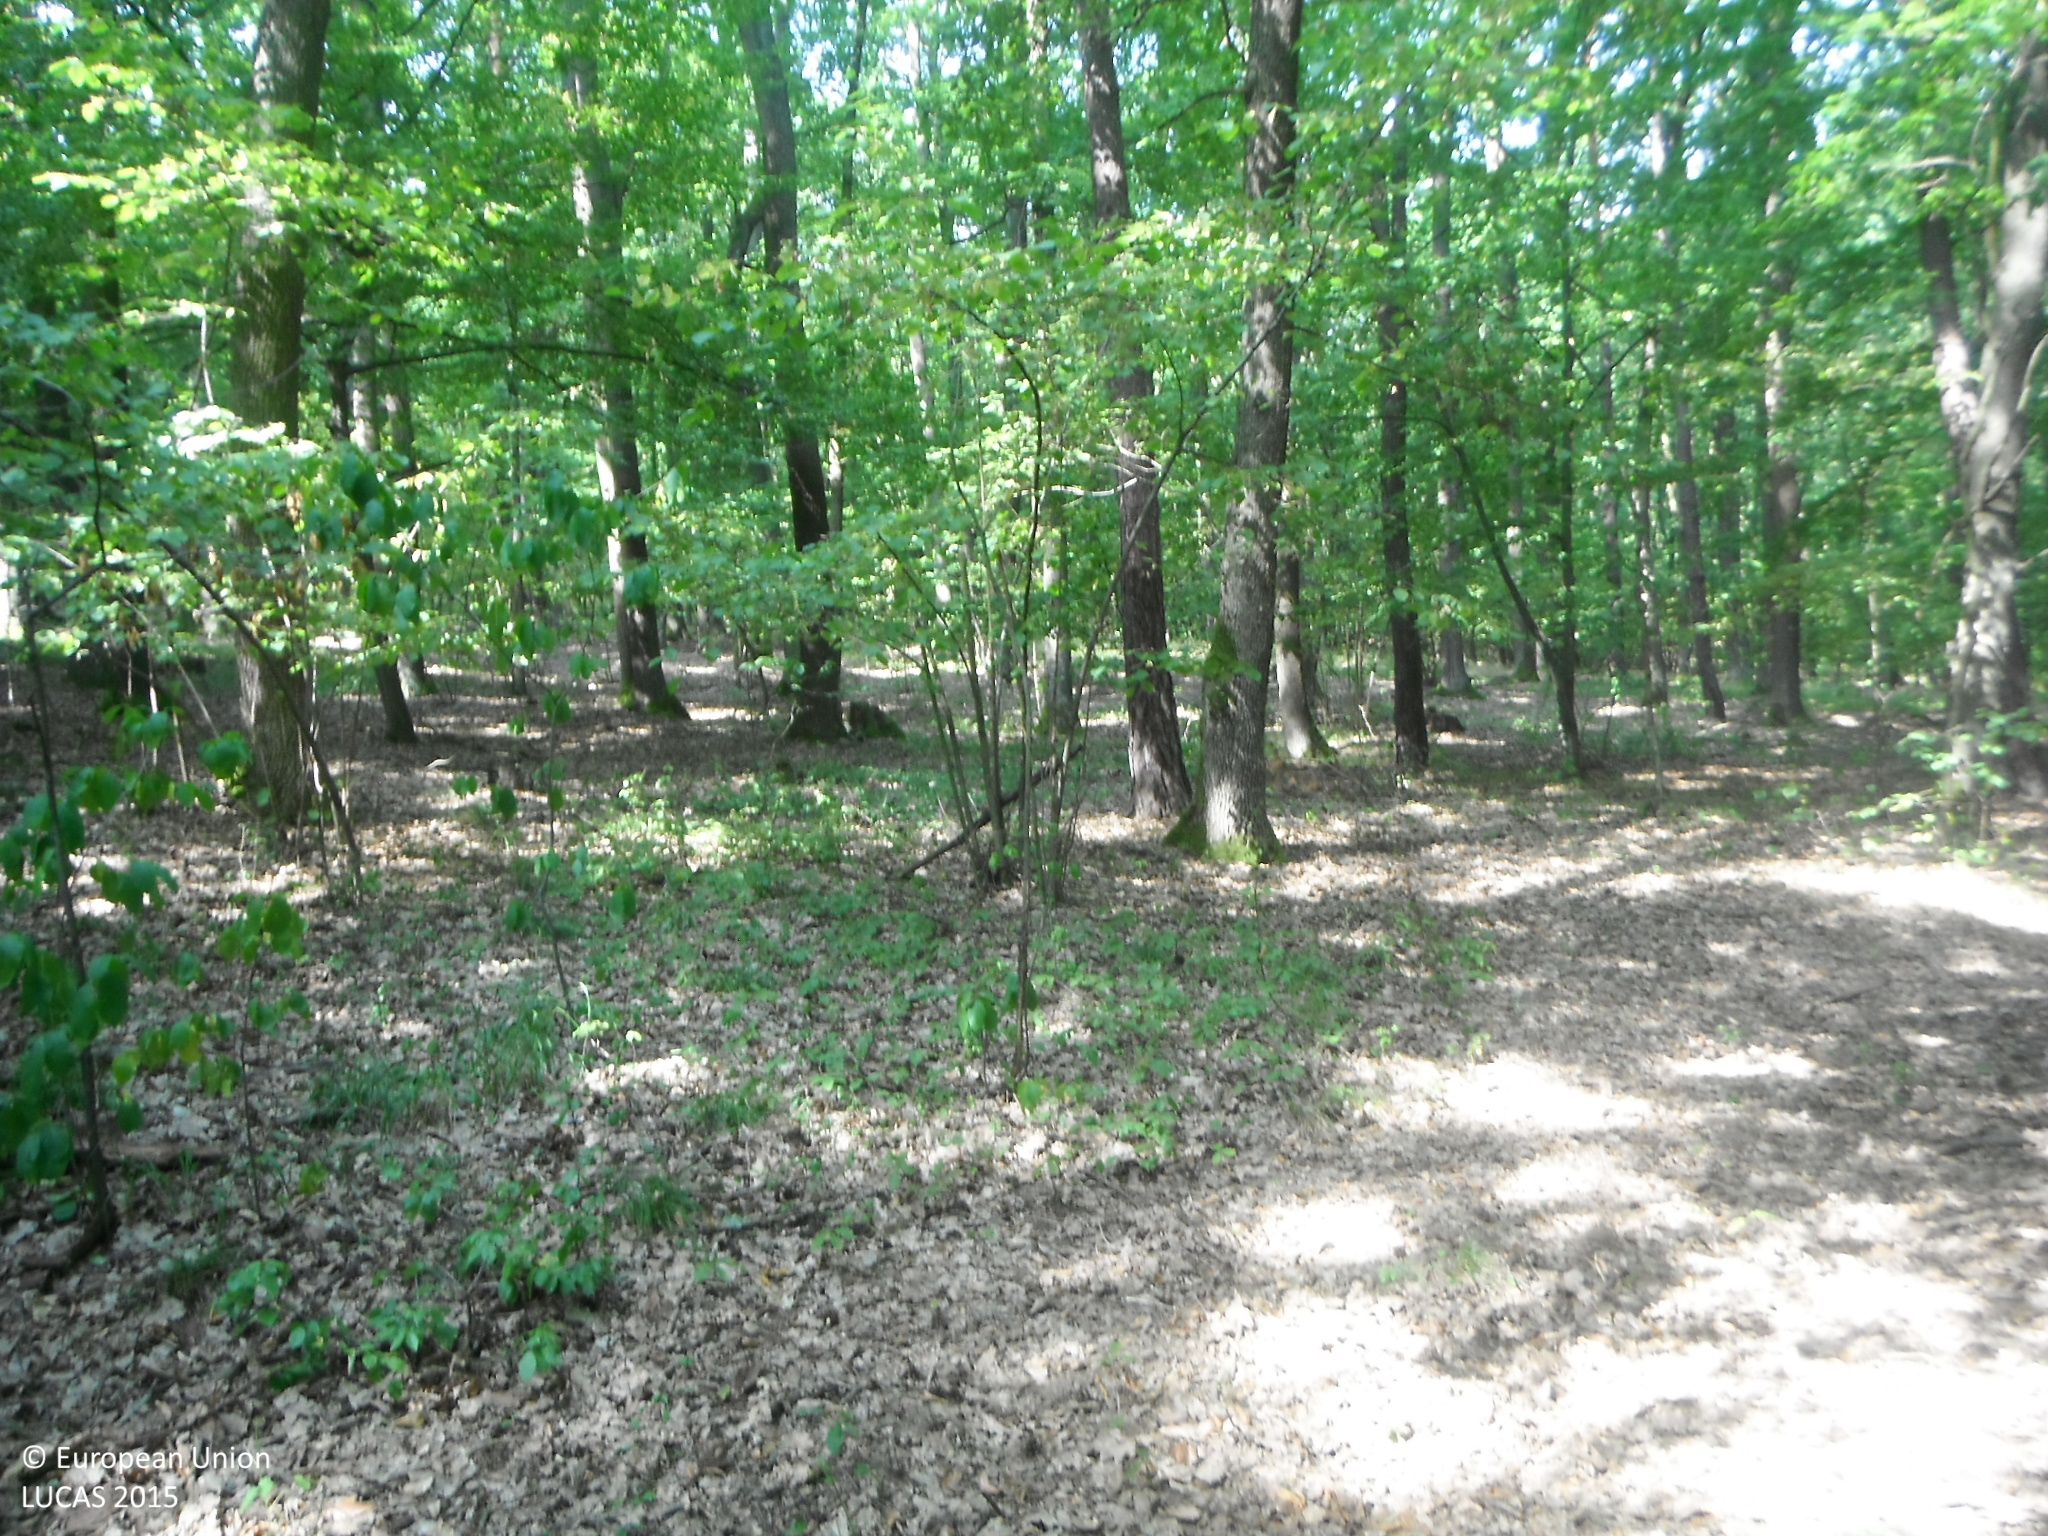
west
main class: Woodland
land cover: Broadleaved woodland
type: acidophilous oak and oak-birch forest
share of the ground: > 75 %
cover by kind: broadleaved forest trees 95 %, shrubs 5 %
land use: Forestry
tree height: > 5 m
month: August
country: SK
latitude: 48.7166
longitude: 18.1564
